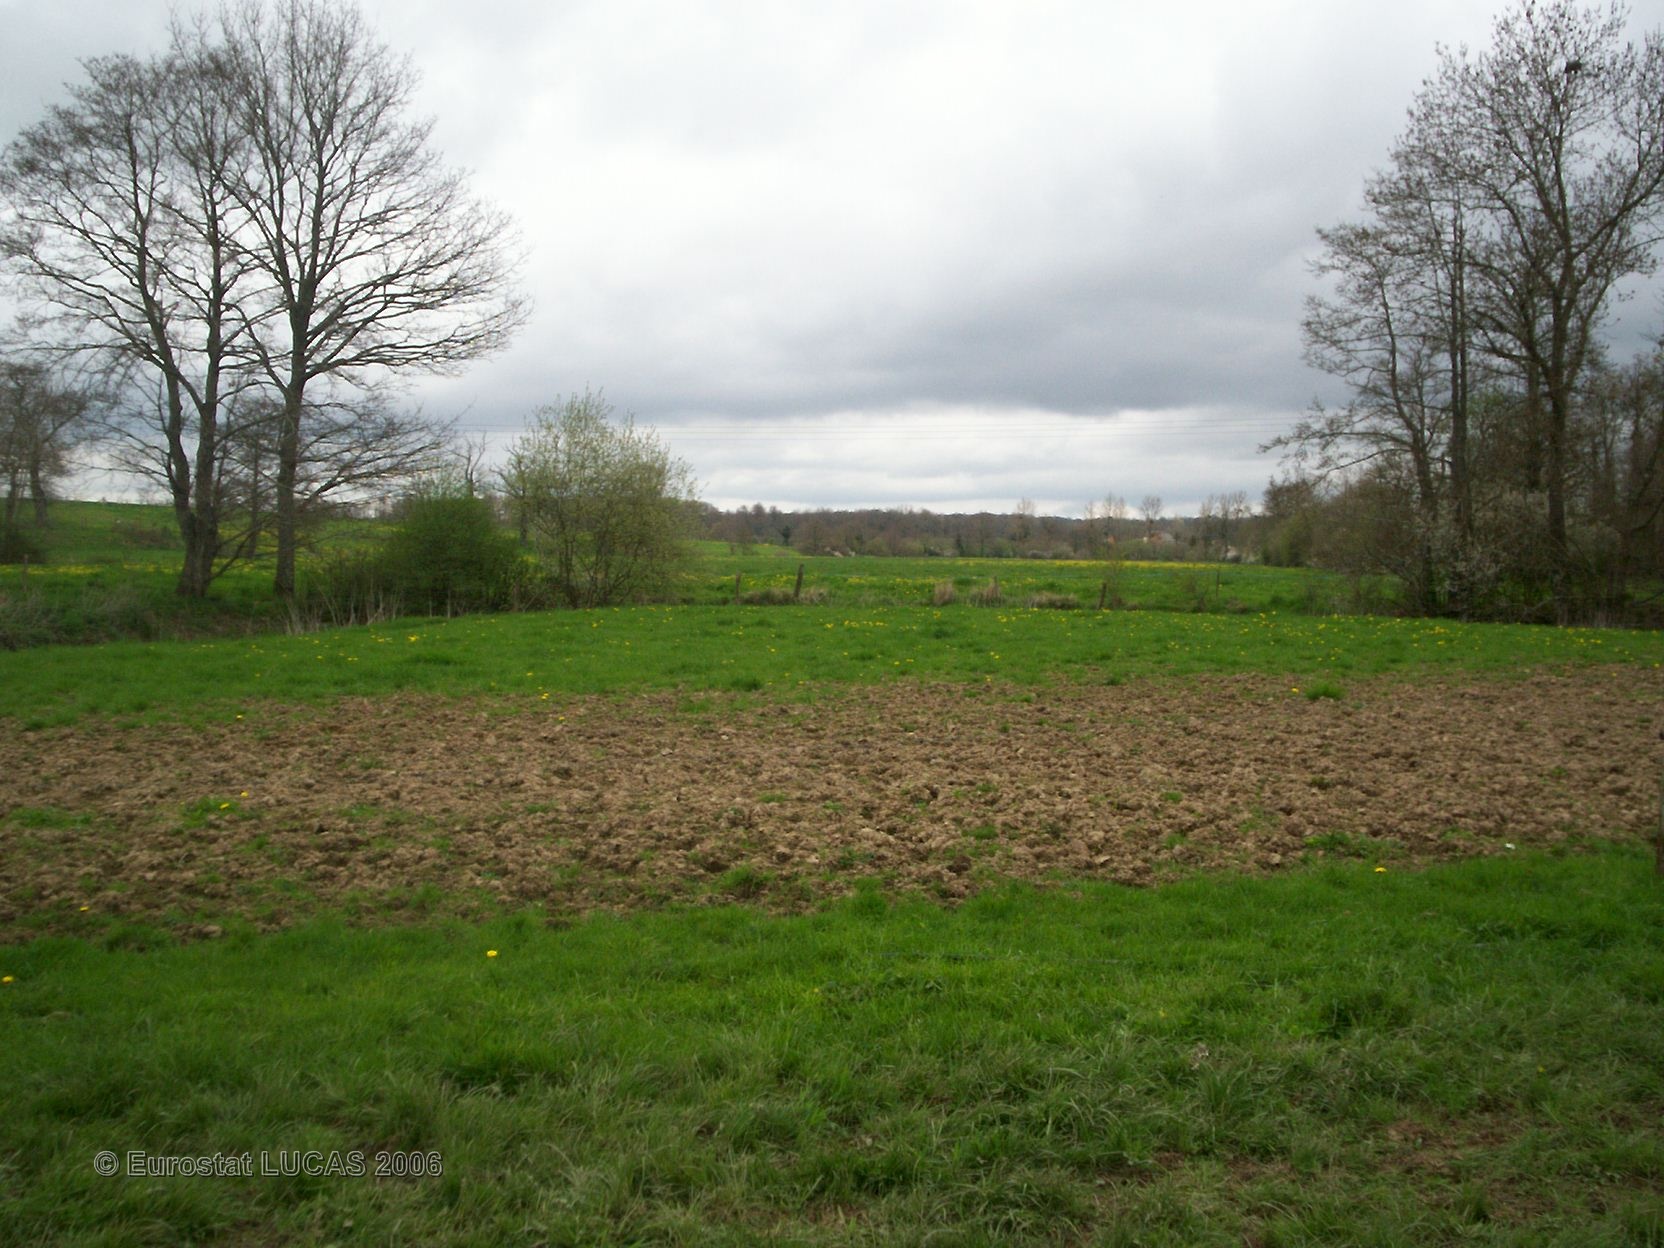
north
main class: Grassland
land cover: Grassland without tree/shrub cover
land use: Agriculture (excluding fallow land and kitchen gardens)
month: April
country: FR
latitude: 48.7146
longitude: -0.3495
